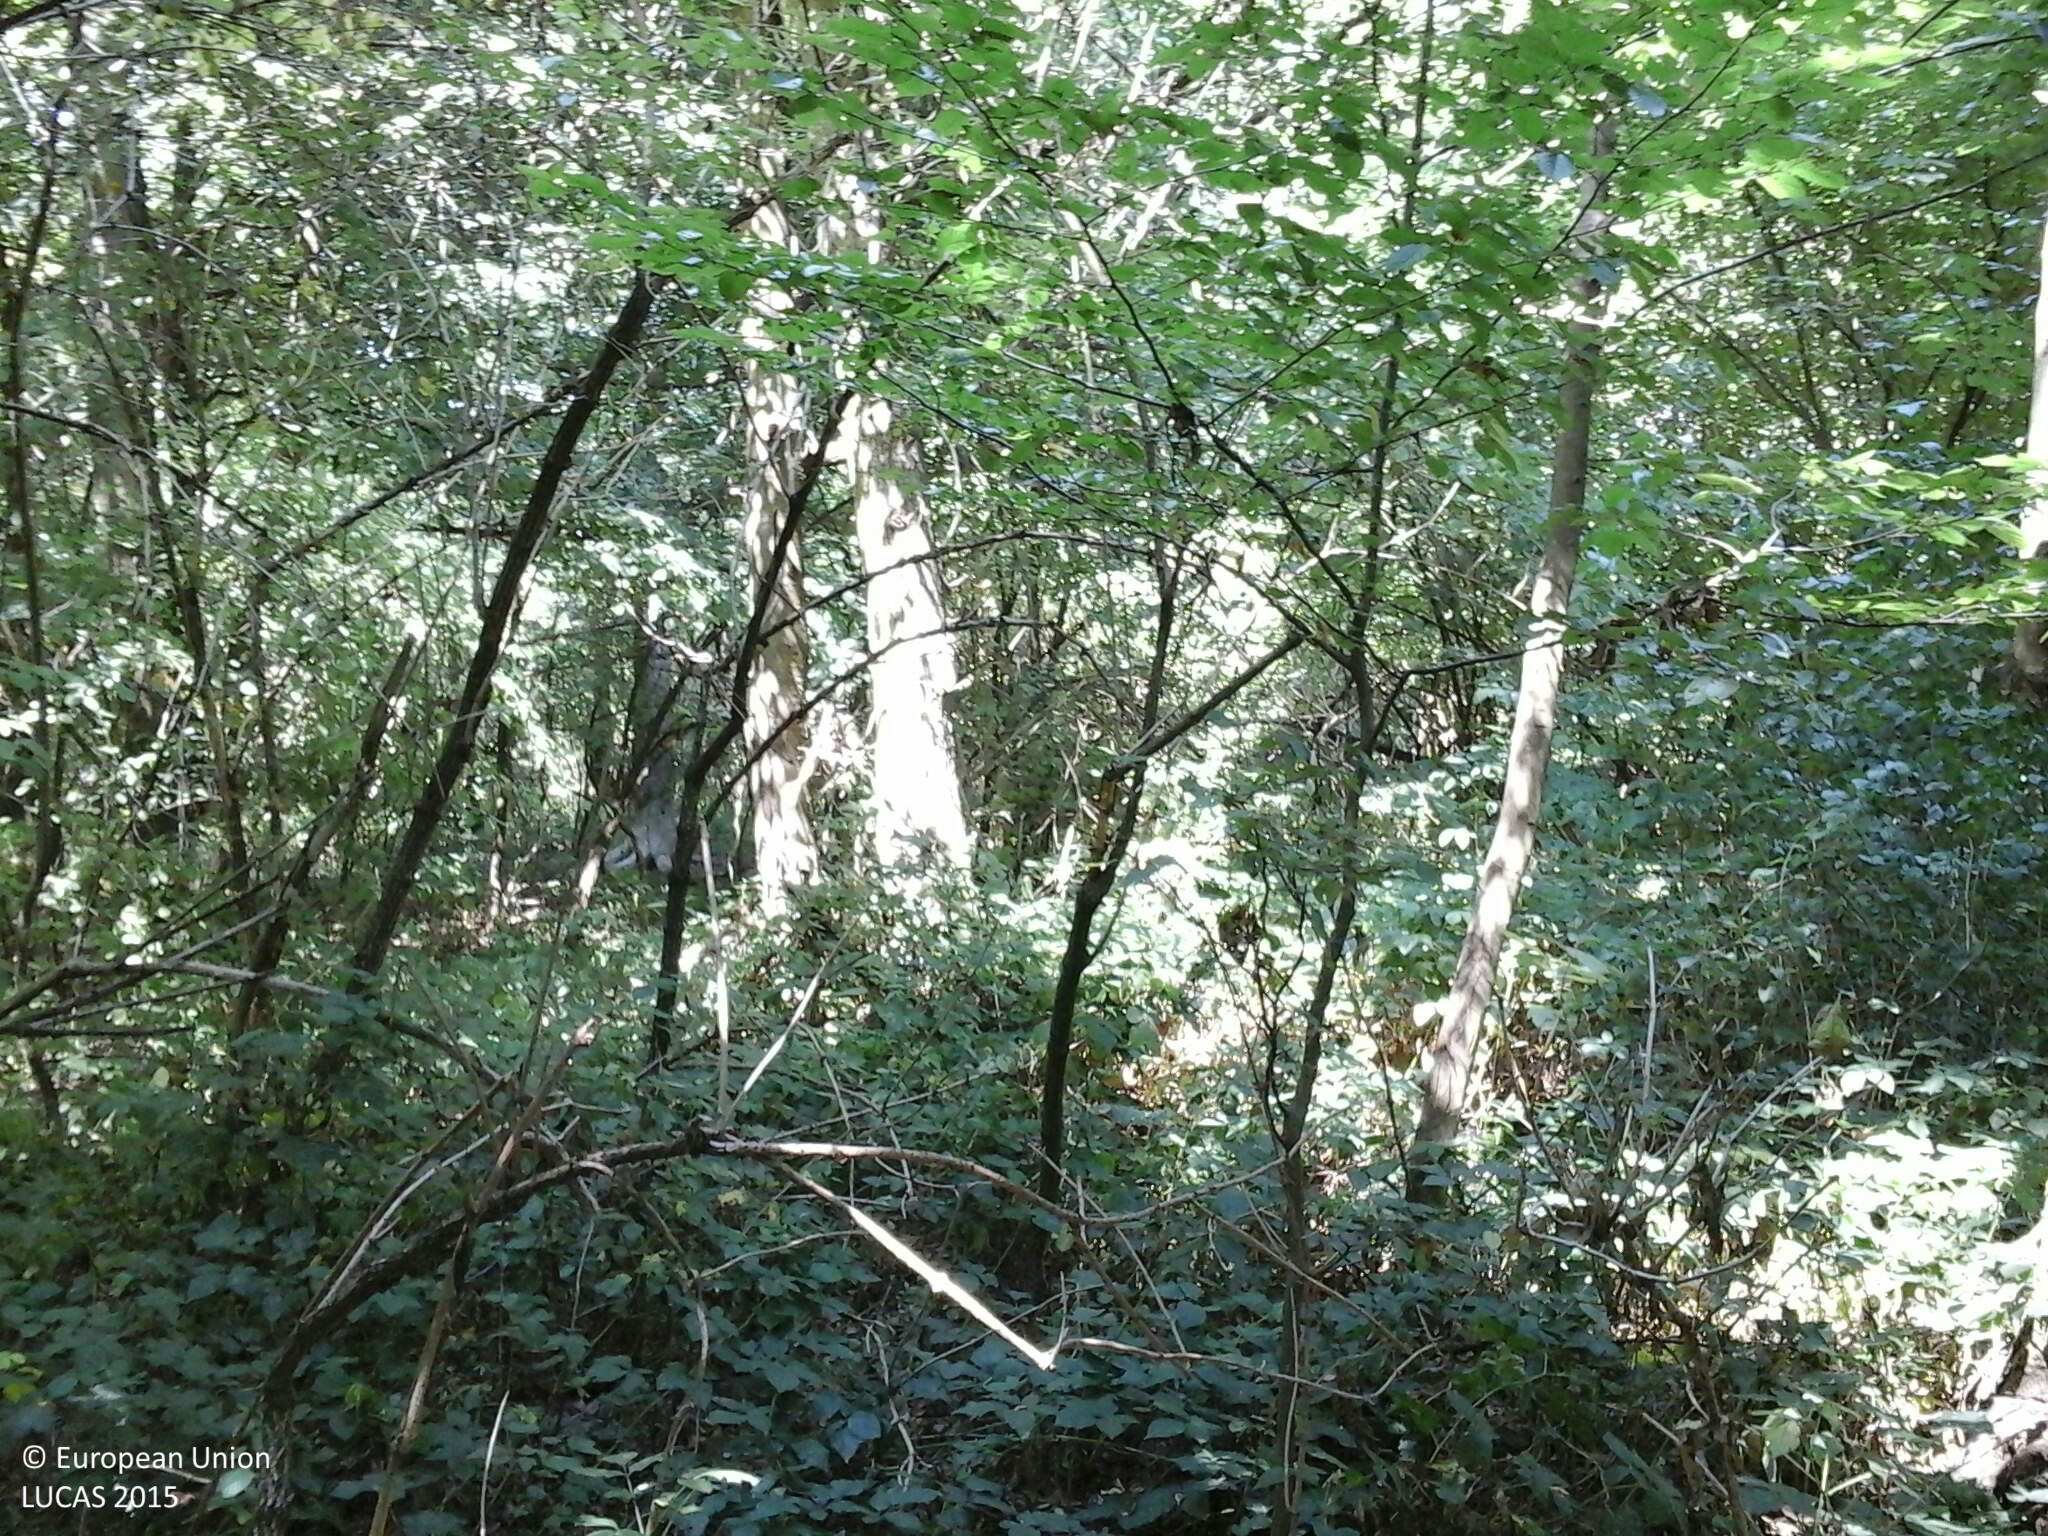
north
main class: Woodland
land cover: Broadleaved woodland
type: mesophytic deciduous forest
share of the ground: > 75 %
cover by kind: broadleaved forest trees 80 %, shrubs 20 %
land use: Forestry
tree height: > 5 m
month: July
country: HU
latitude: 46.9937
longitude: 16.6435
